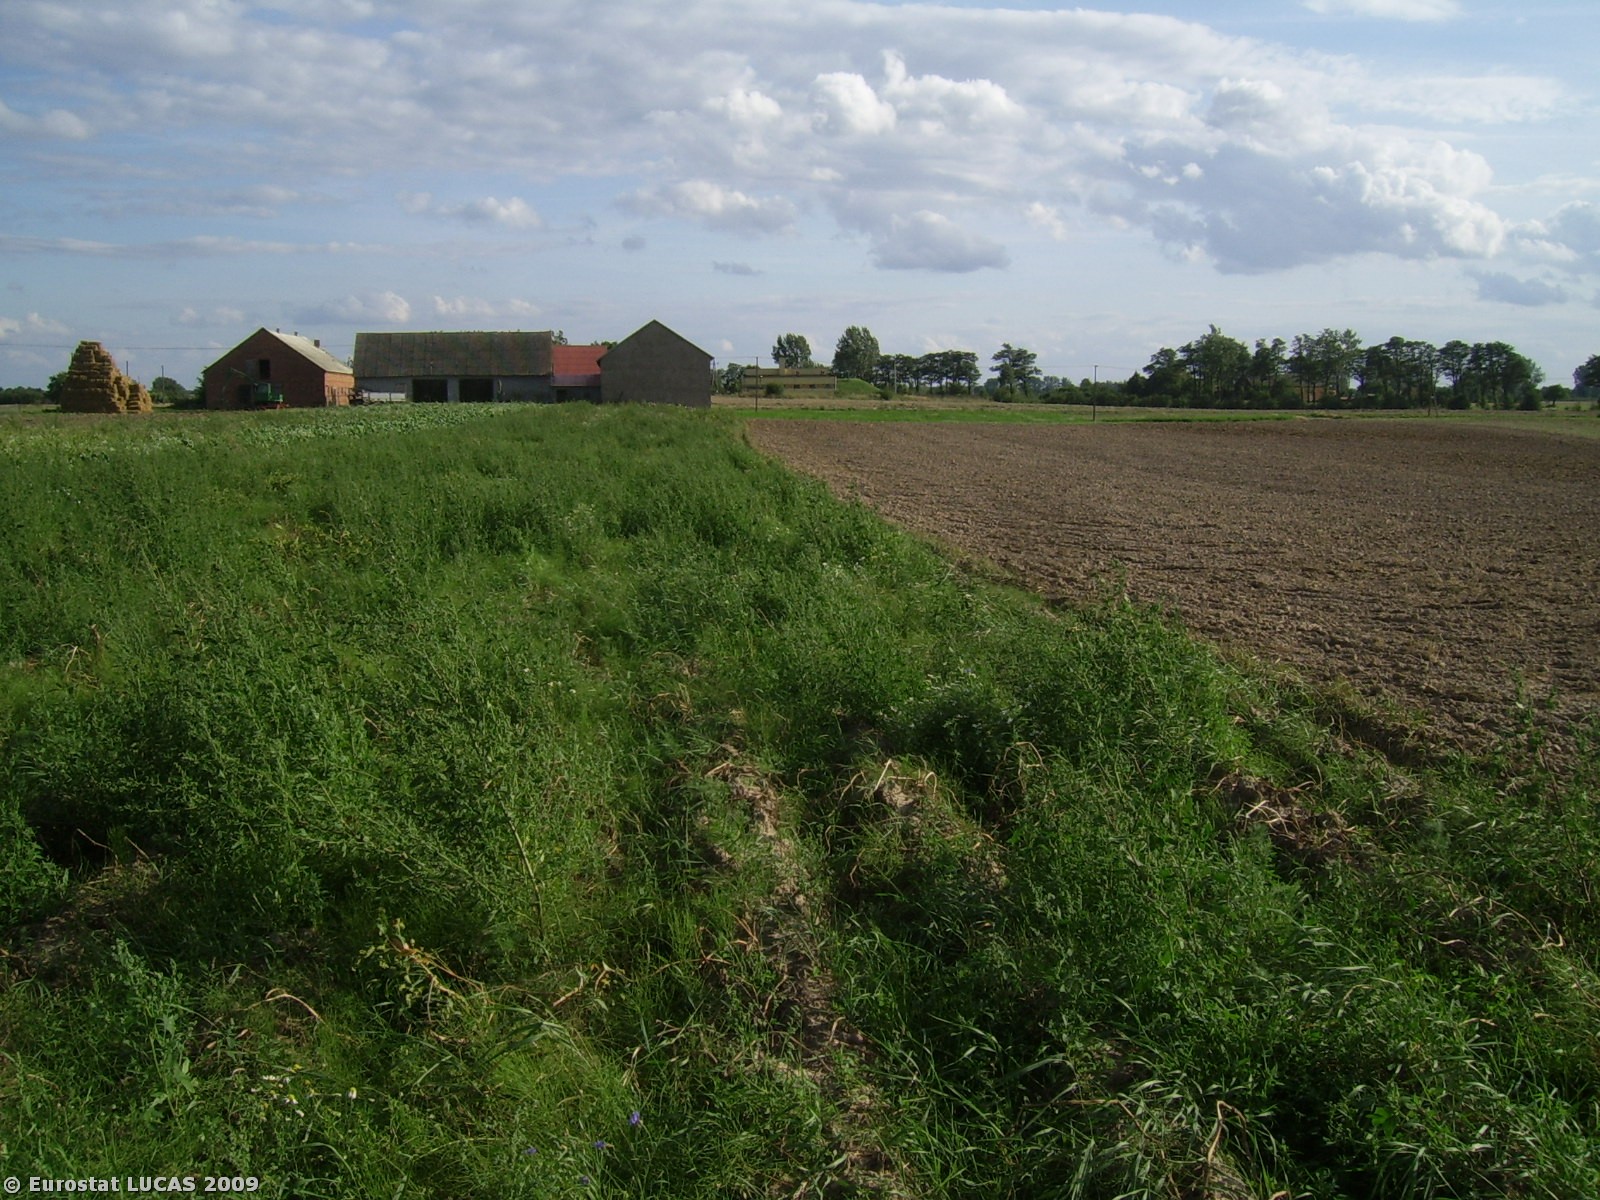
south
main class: Cropland
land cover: Potatoes
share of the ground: > 75 %
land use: Agriculture (excluding fallow land and kitchen gardens)
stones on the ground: < 10 %
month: August
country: PL
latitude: 52.3736
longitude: 18.5832
